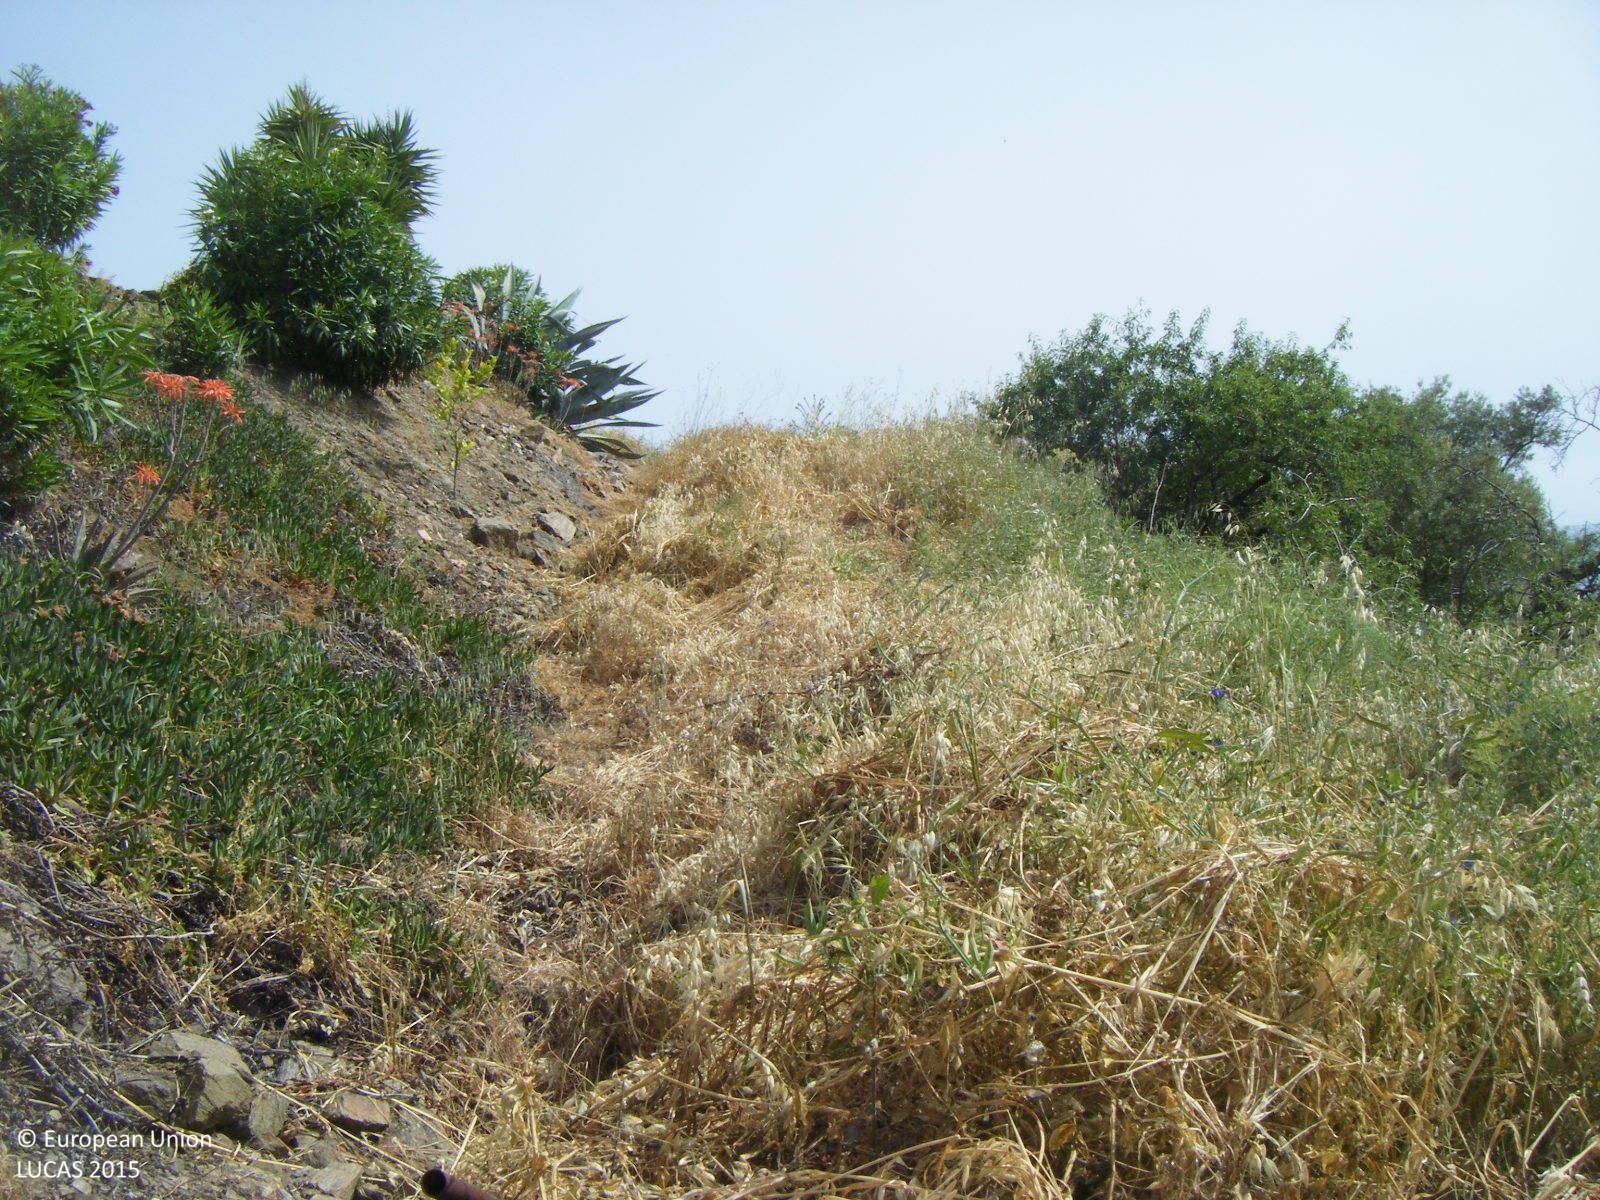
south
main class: Grassland
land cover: Grassland without tree/shrub cover
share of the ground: > 75 %
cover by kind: herbaceous plants 100 %
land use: Semi-natural and natural areas not in use
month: May
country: ES
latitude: 36.8084
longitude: -4.0547
